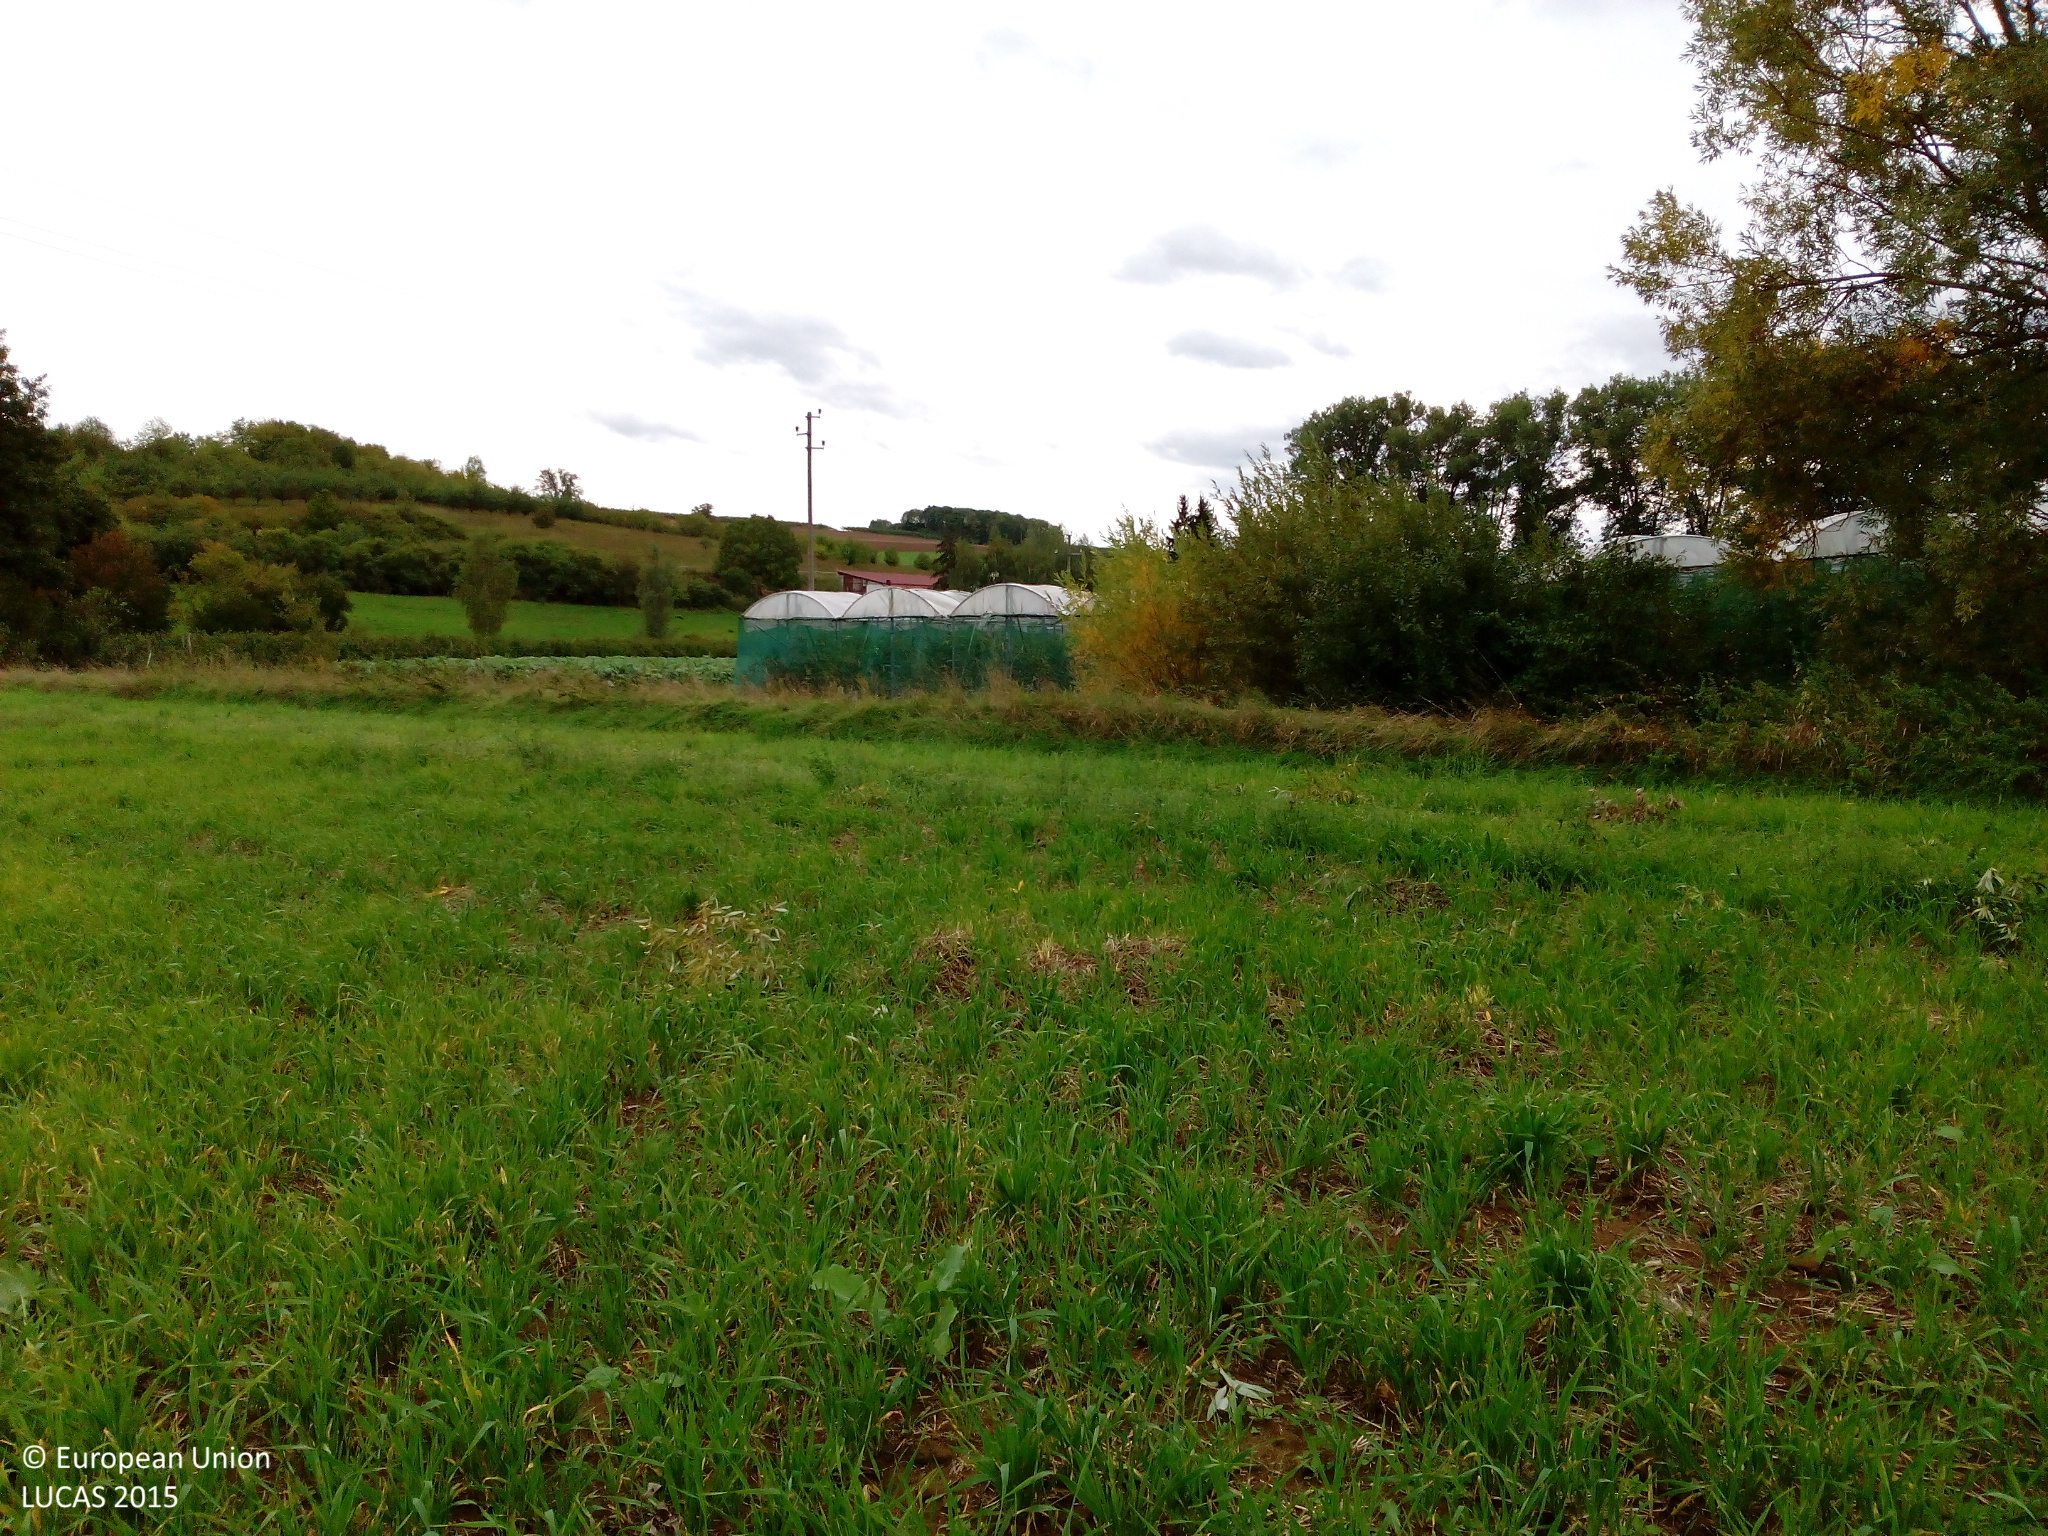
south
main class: Cropland
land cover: Barley
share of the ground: 50 - 75 %
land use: Agriculture (excluding fallow land and kitchen gardens)
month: September
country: DE
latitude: 50.0044
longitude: 9.9582
